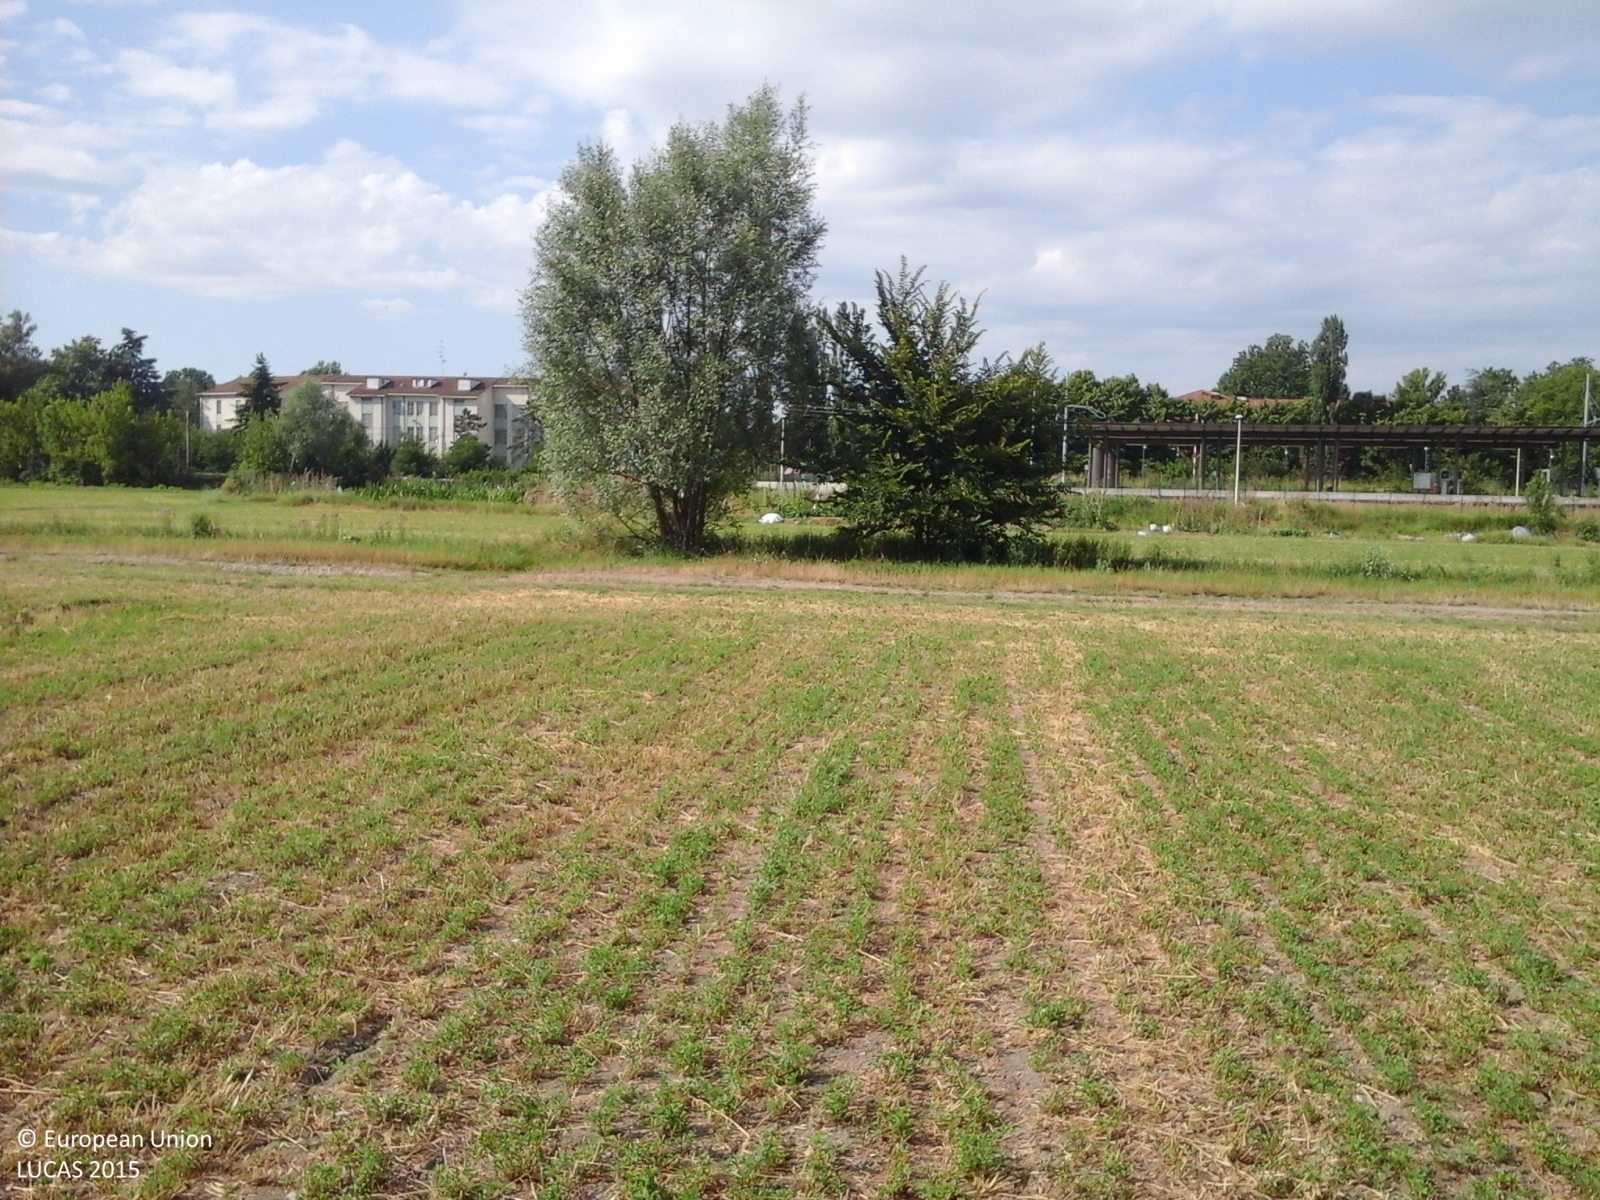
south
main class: Cropland
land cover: Lucerne
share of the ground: > 75 %
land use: Agriculture (excluding fallow land and kitchen gardens)
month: June
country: IT
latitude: 44.6911
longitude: 10.6674
